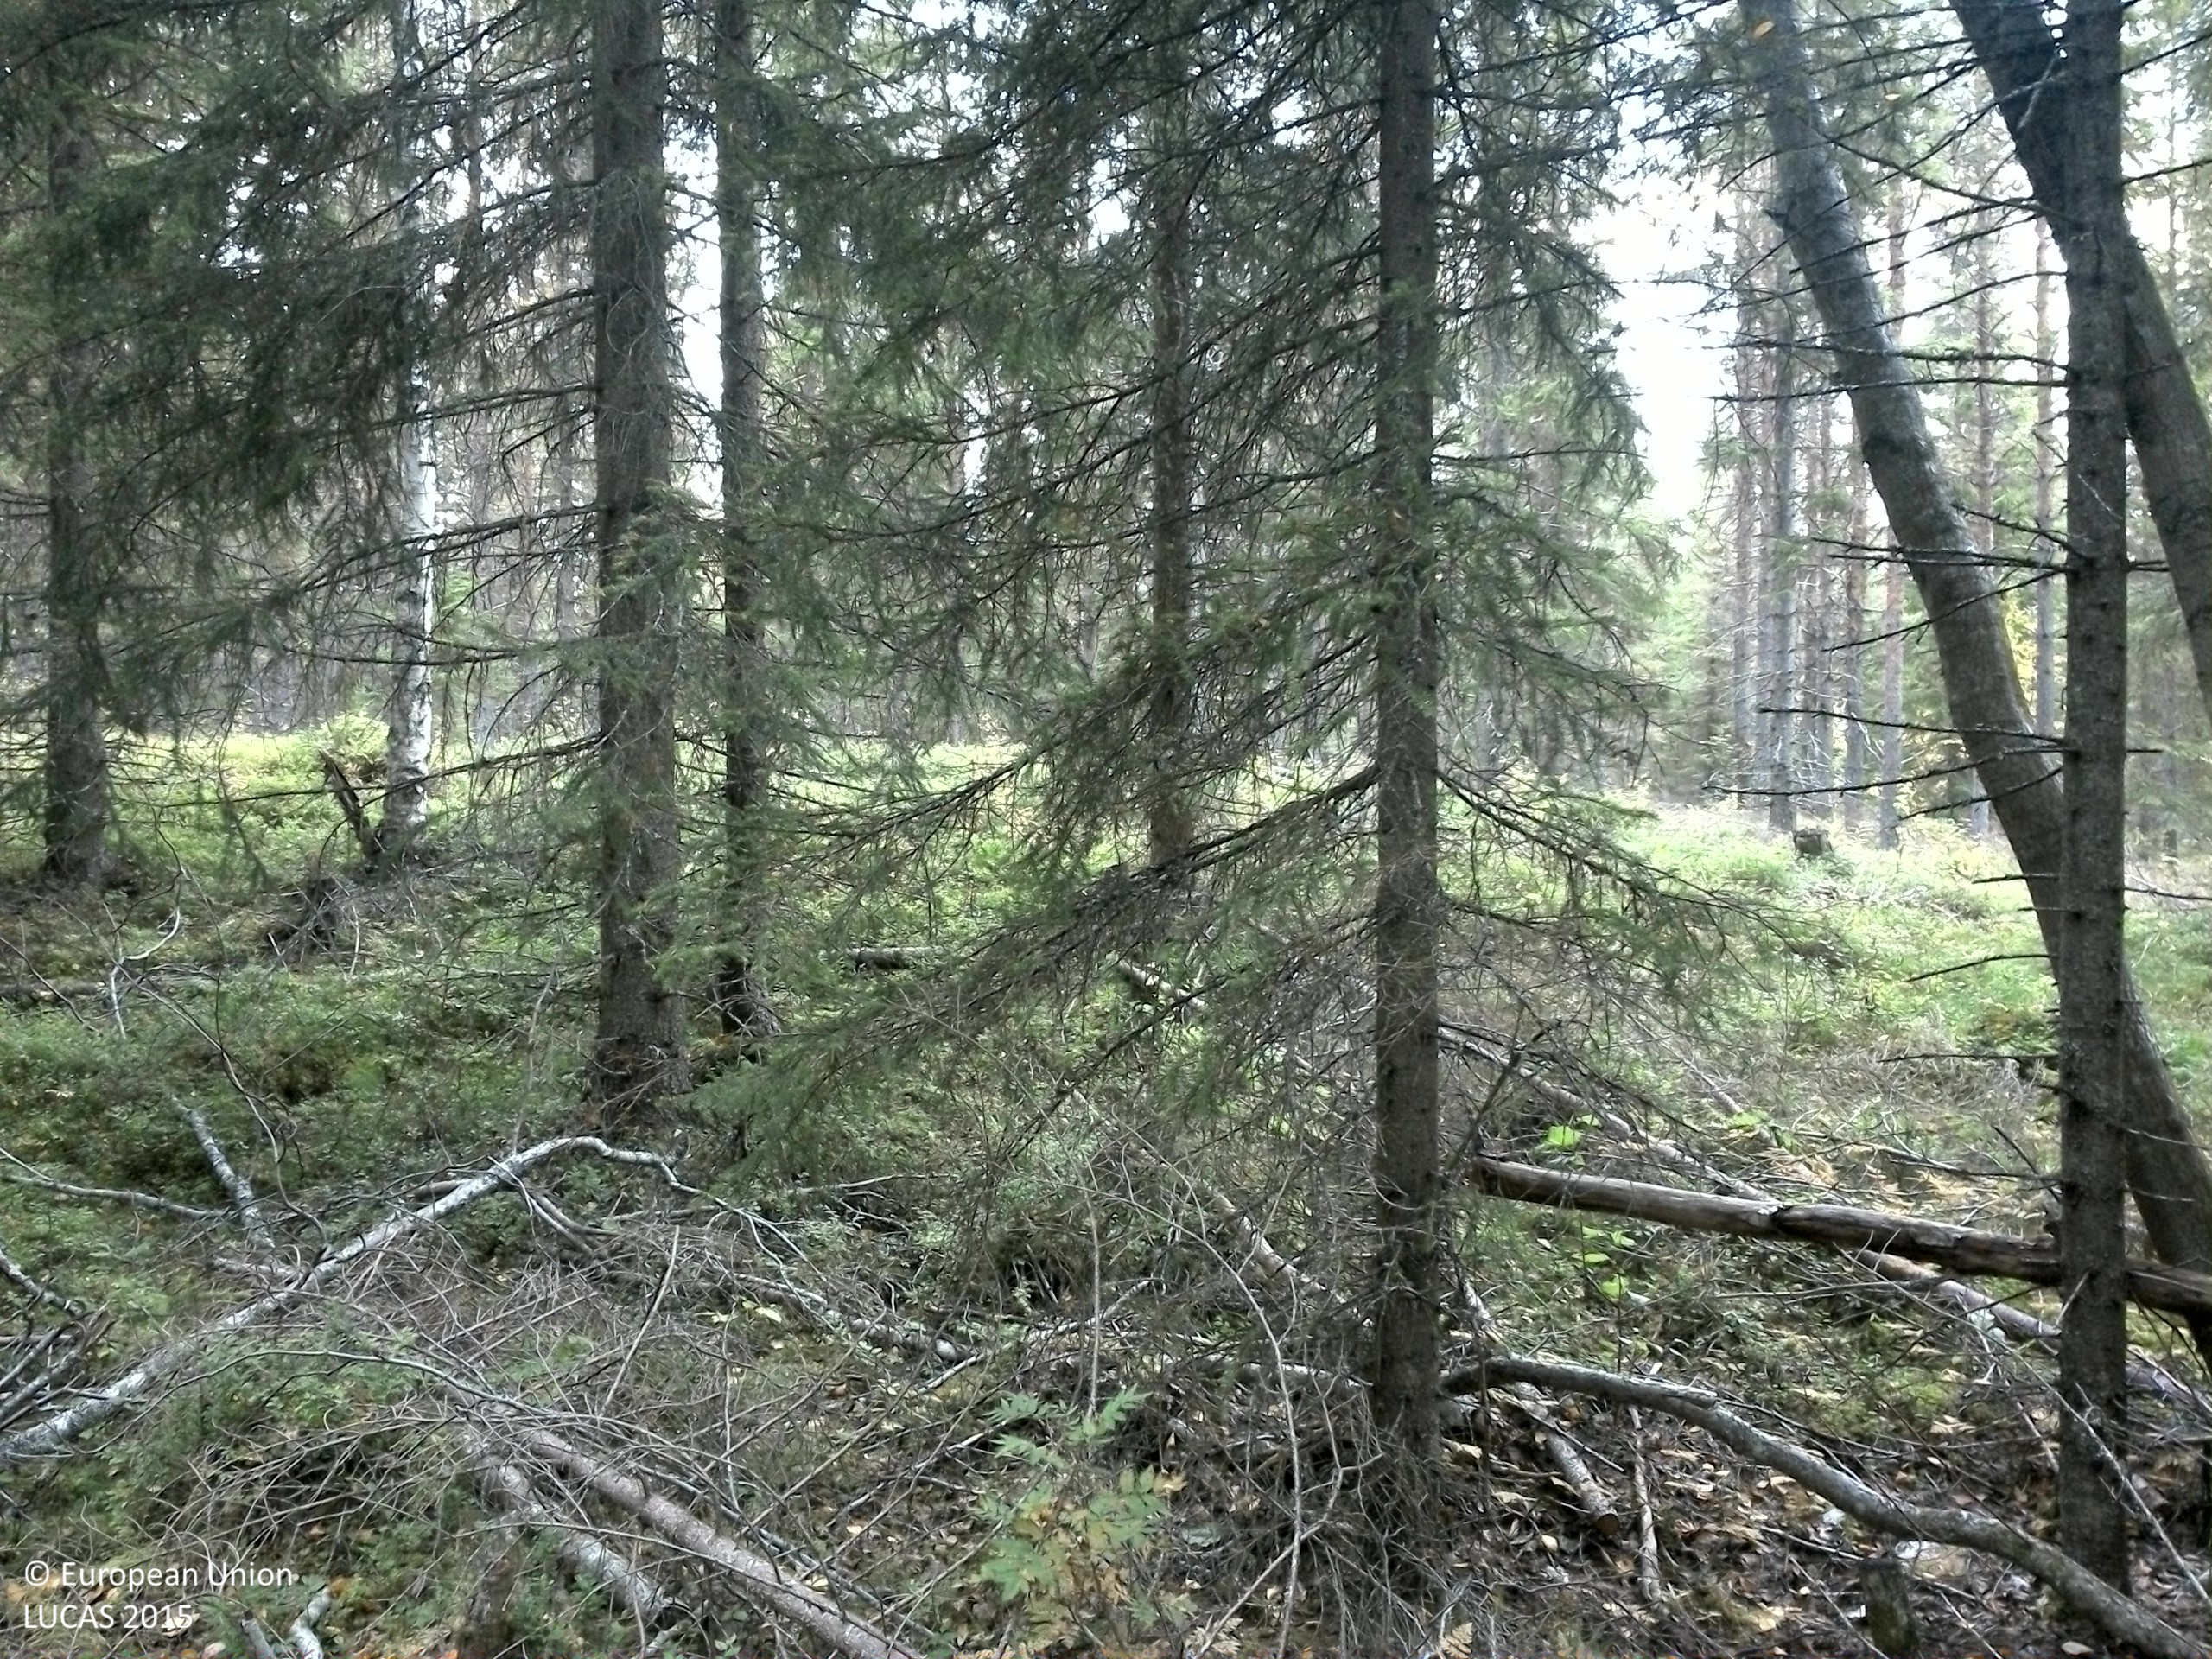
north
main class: Woodland
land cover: Spruce dominated mixed woodland
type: boreal forest
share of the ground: > 75 %
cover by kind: coniferous forest trees 55 %, broadleaved forest trees 20 %, lichens and mosses 10 %, unconsolidated bare surface 10 %, shrubs 5 %
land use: Forestry
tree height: > 5 m
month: September
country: SE
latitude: 63.6371
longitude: 15.8878
